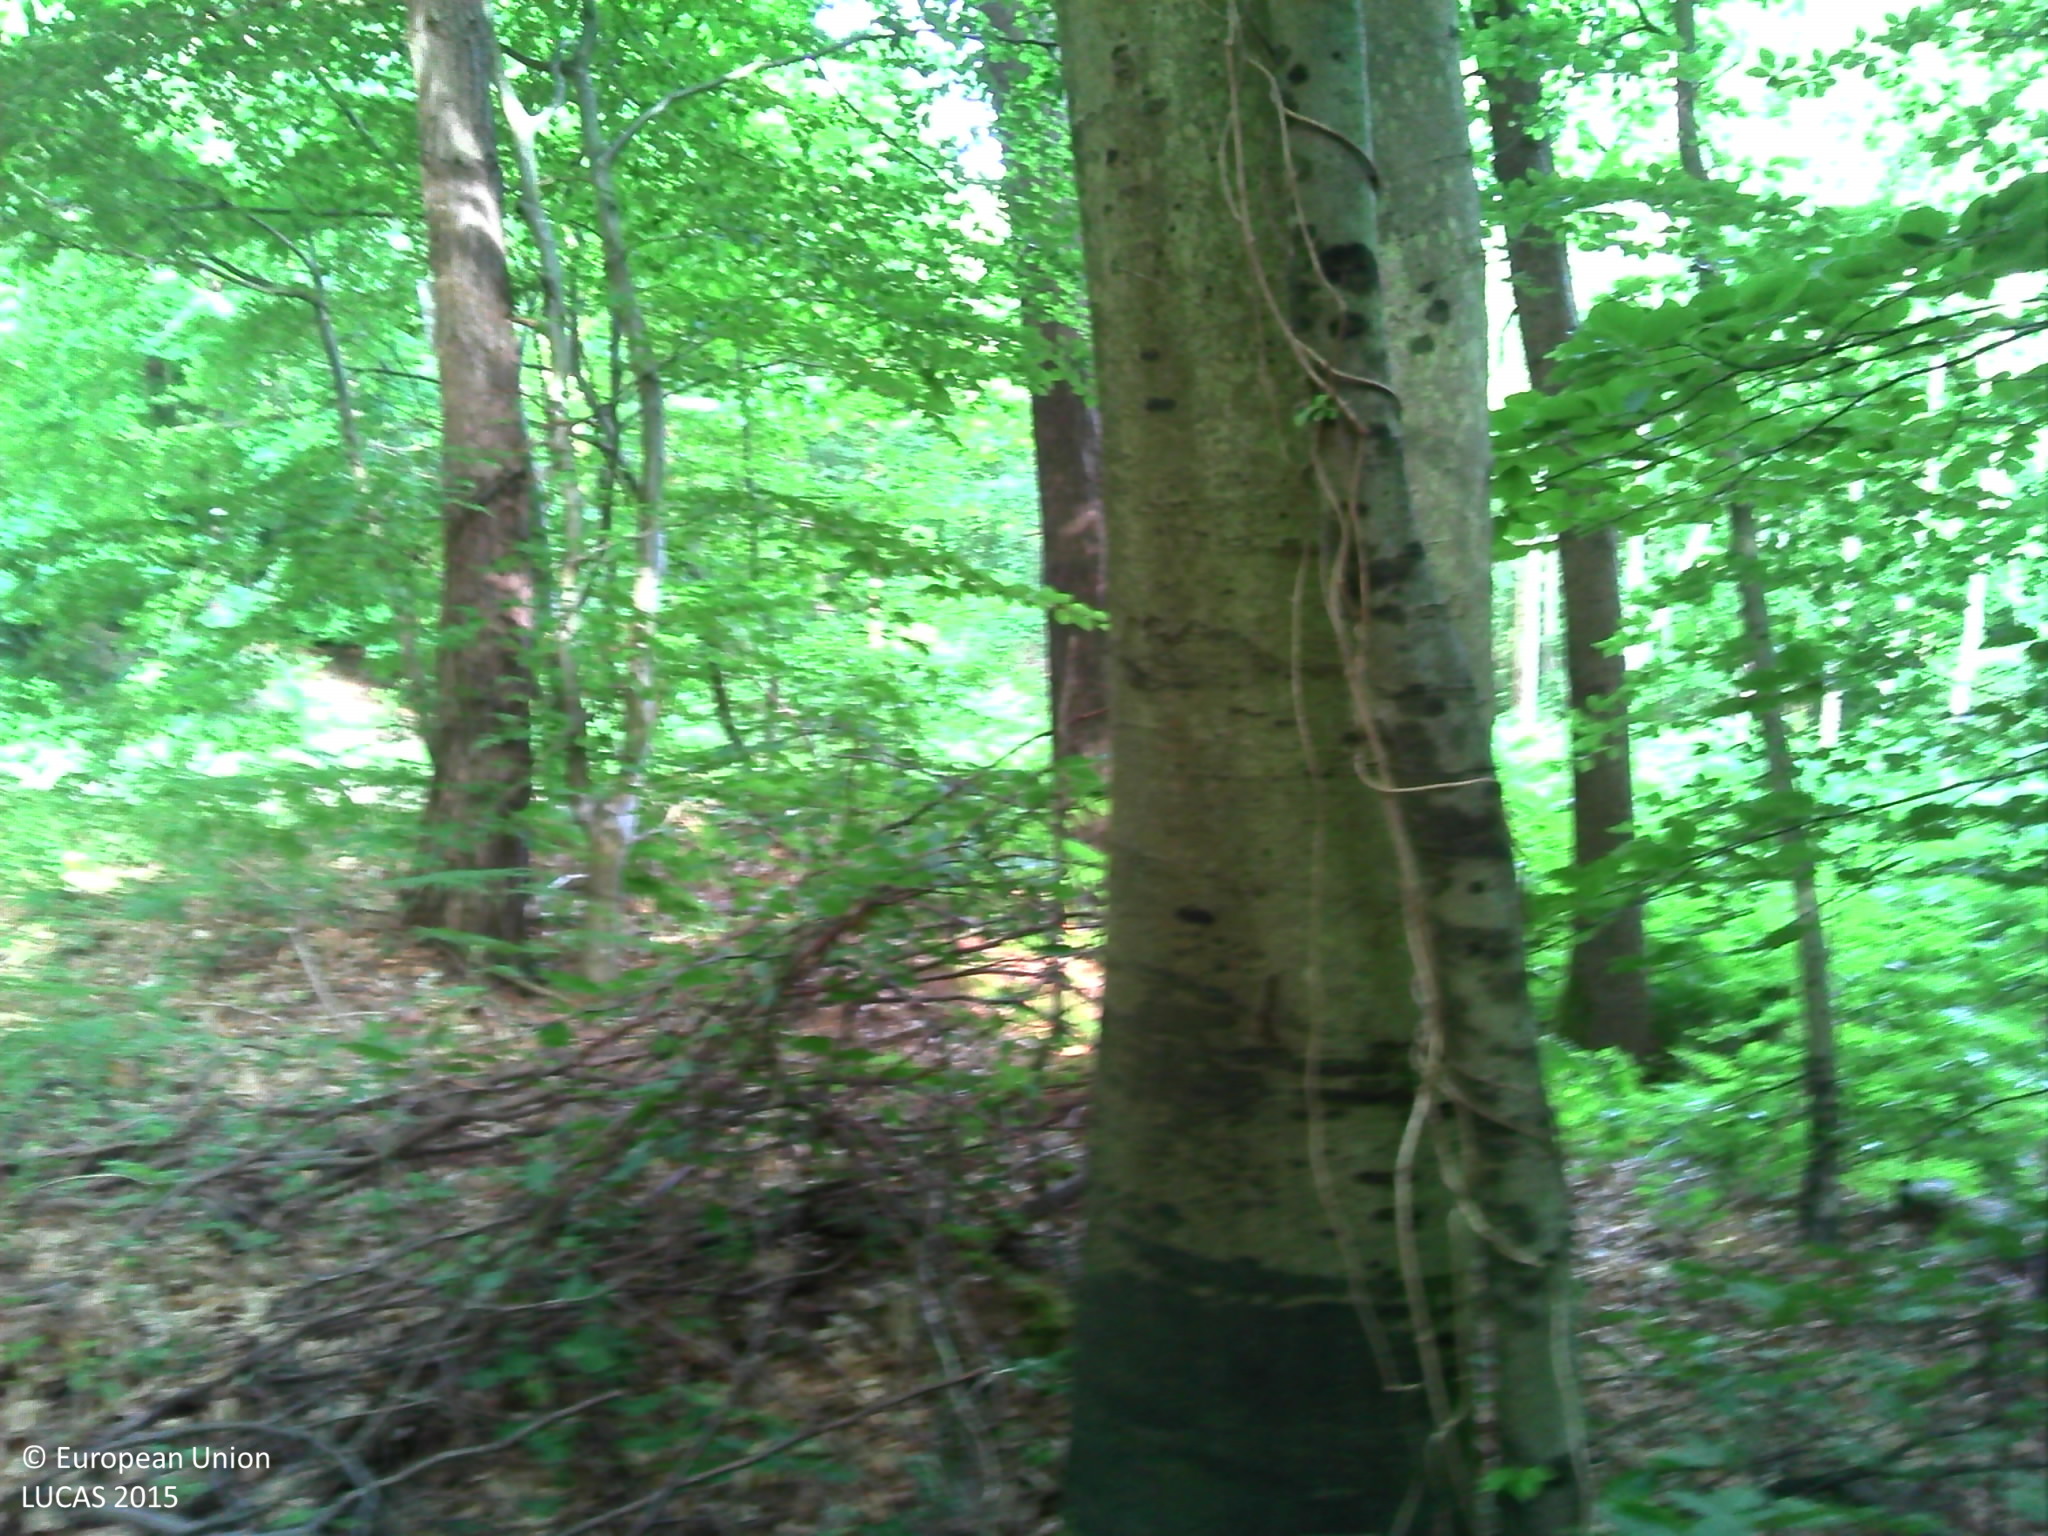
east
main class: Woodland
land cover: Other mixed woodland
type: beech forest
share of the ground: > 75 %
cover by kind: broadleaved forest trees 70 %, coniferous forest trees 25 %, herbaceous plants 5 %
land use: Forestry
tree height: > 5 m
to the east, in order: Other mixed woodland; Tracks; Grass margins; Broadleaved woodland
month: June
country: FR
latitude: 49.2623
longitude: 1.1712
